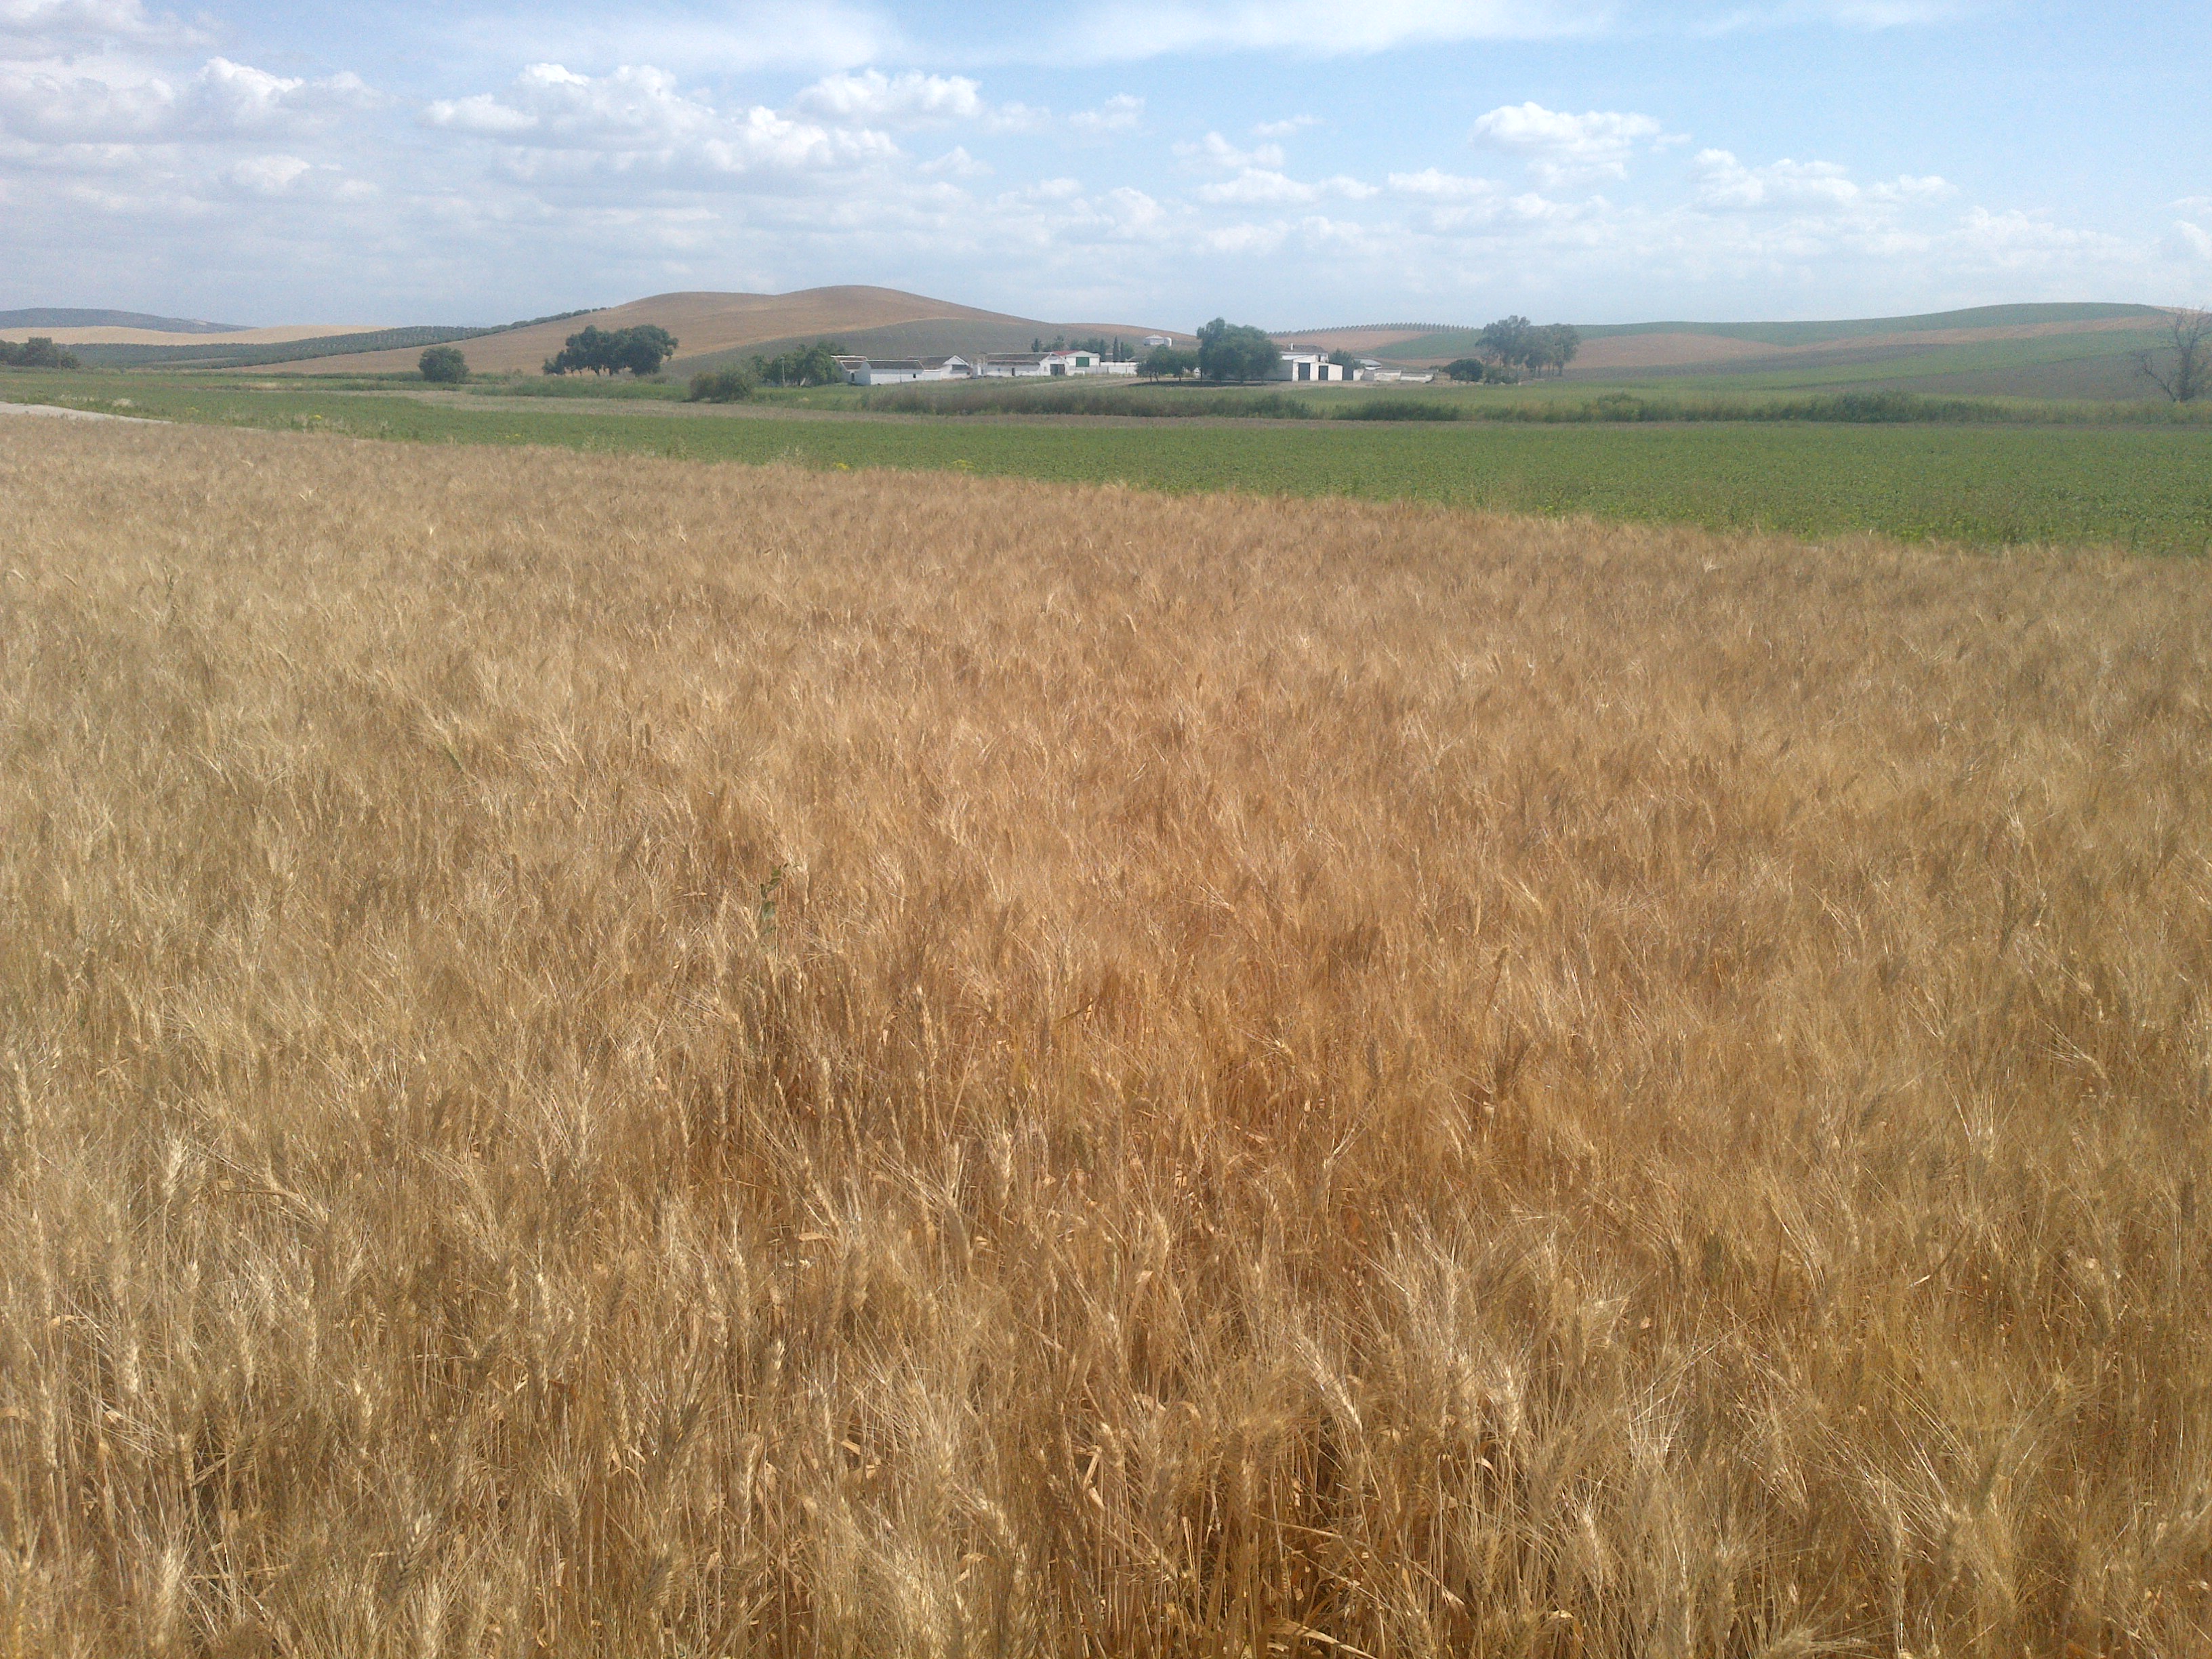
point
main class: Cropland
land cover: Durum wheat
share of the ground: > 75 %
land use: Agriculture (excluding fallow land and kitchen gardens)
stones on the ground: 10 - 25 %
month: May
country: ES
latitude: 37.8502
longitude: -4.4543
